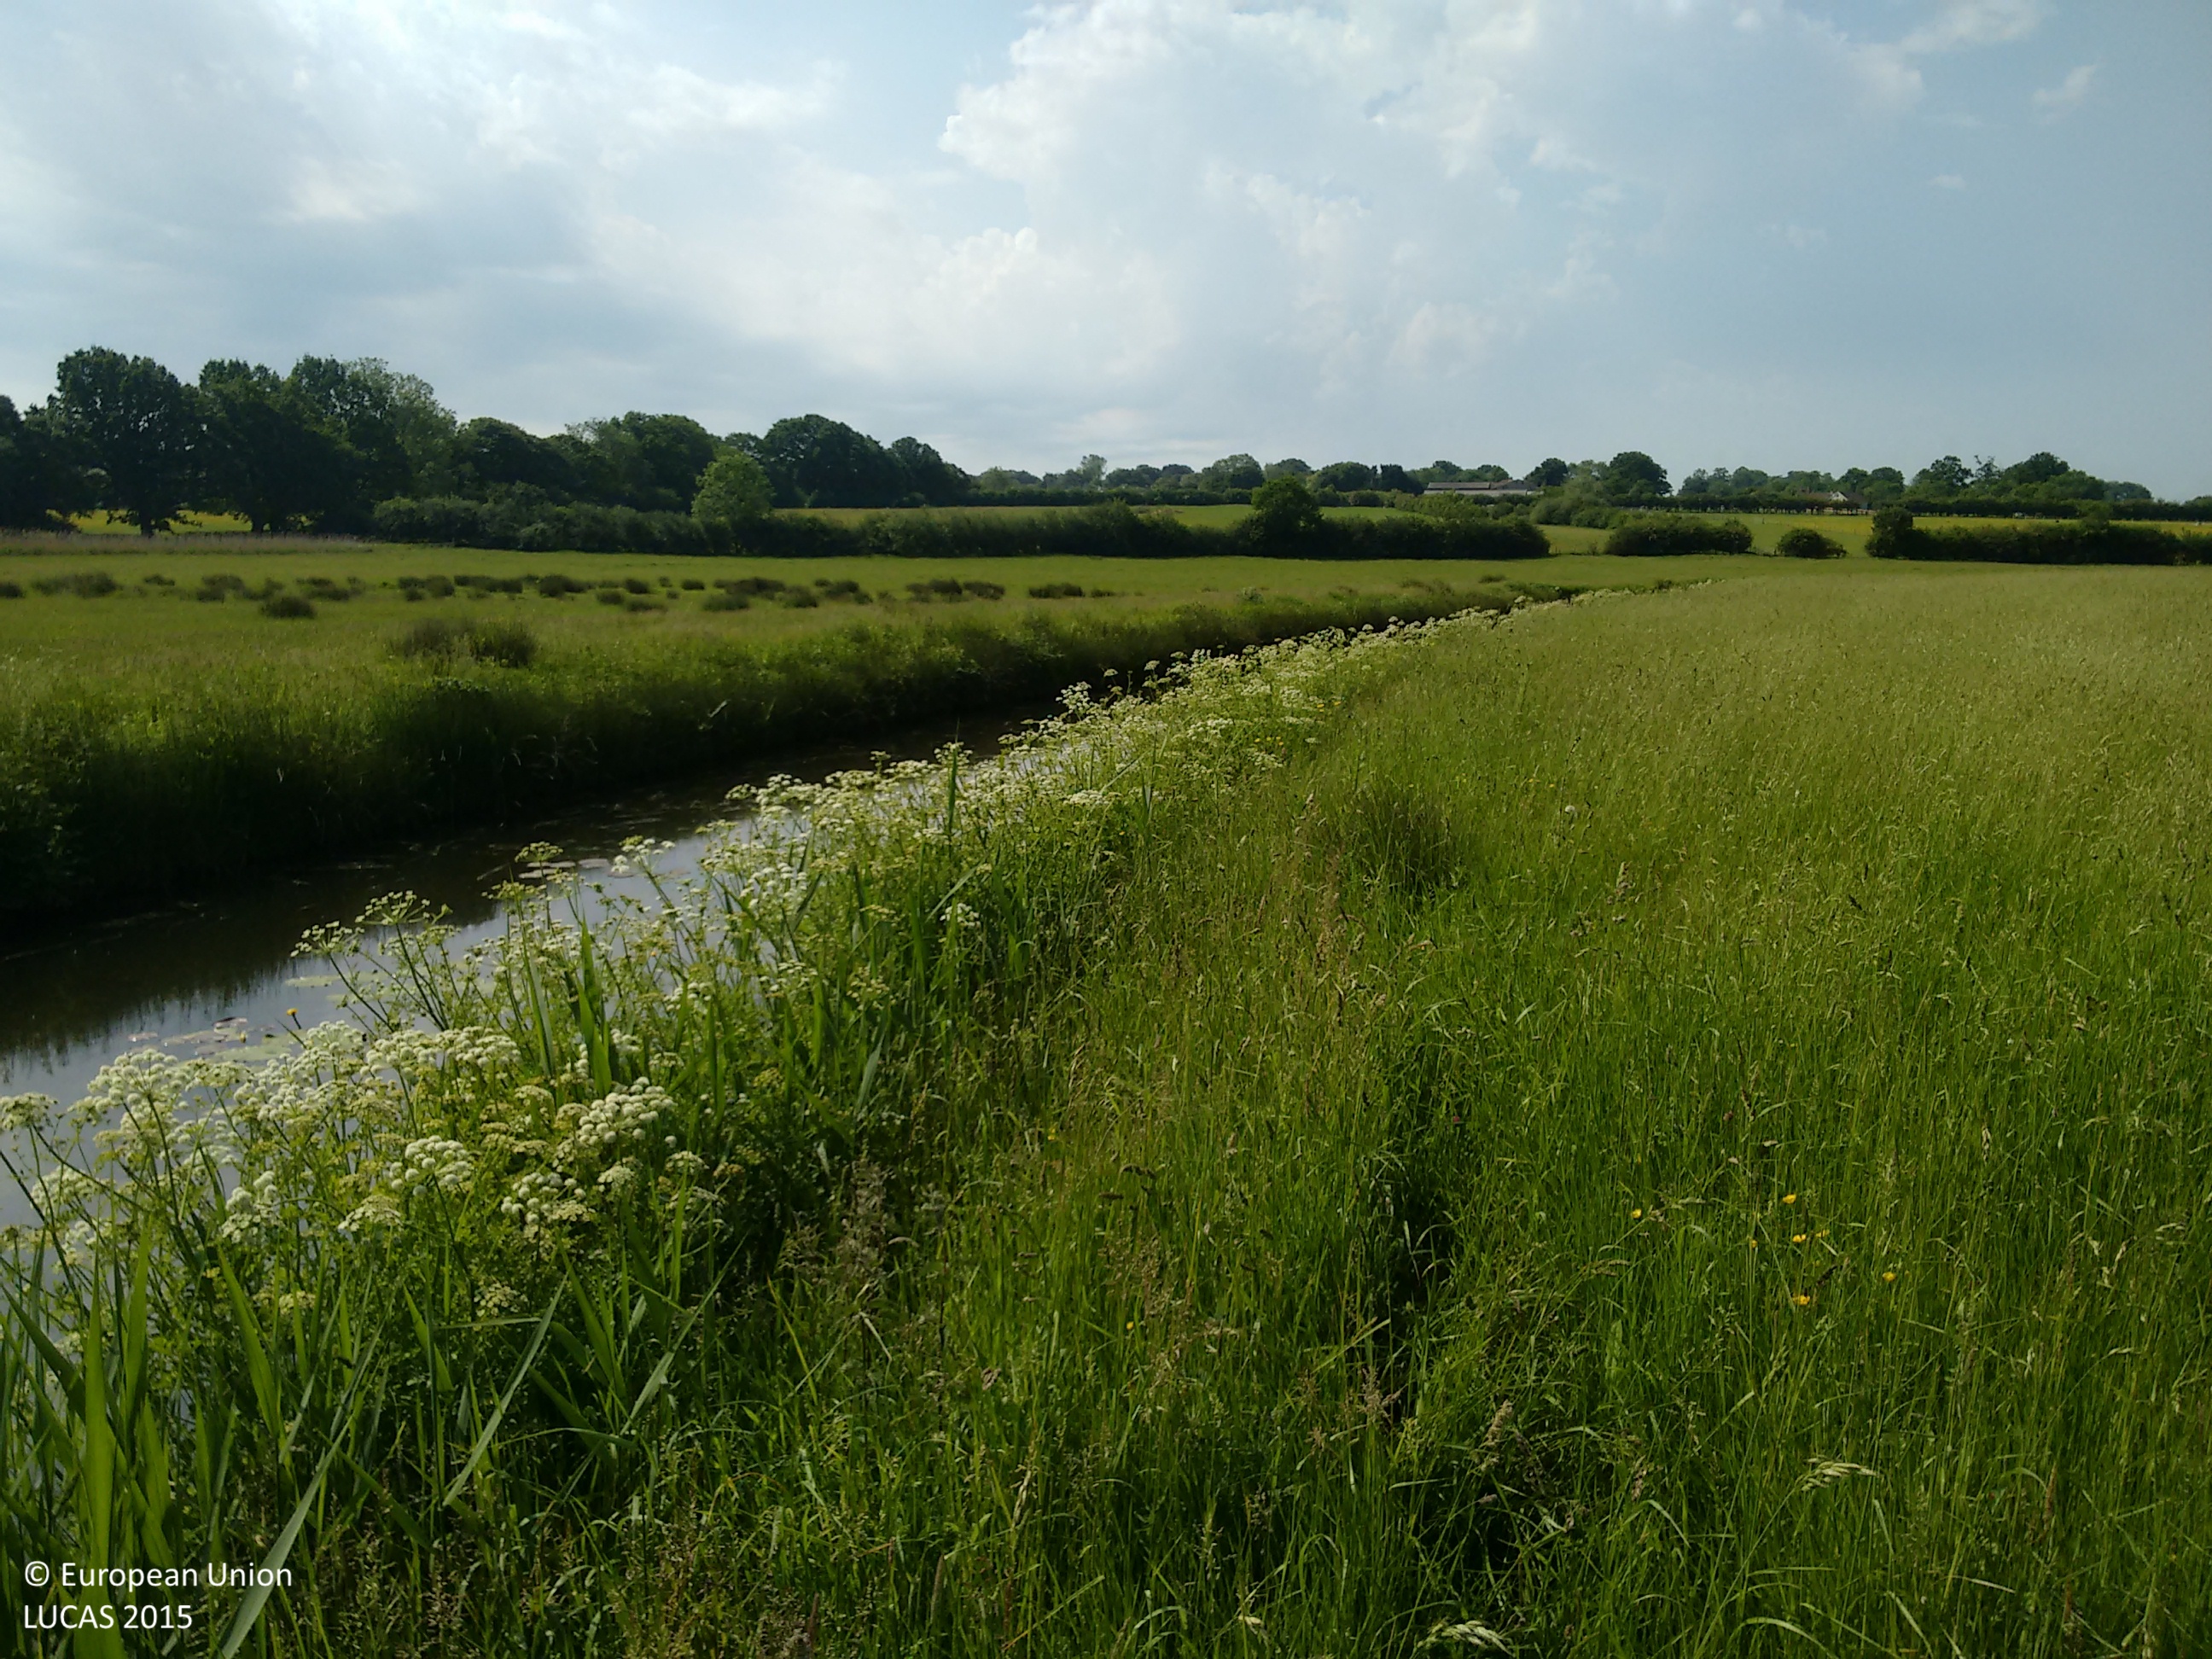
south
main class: Grassland
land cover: Grassland without tree/shrub cover
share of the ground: > 75 %
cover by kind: herbaceous plants 100 %
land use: Agriculture (excluding fallow land and kitchen gardens)
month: June
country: GB
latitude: 51.0336
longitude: 0.6906
